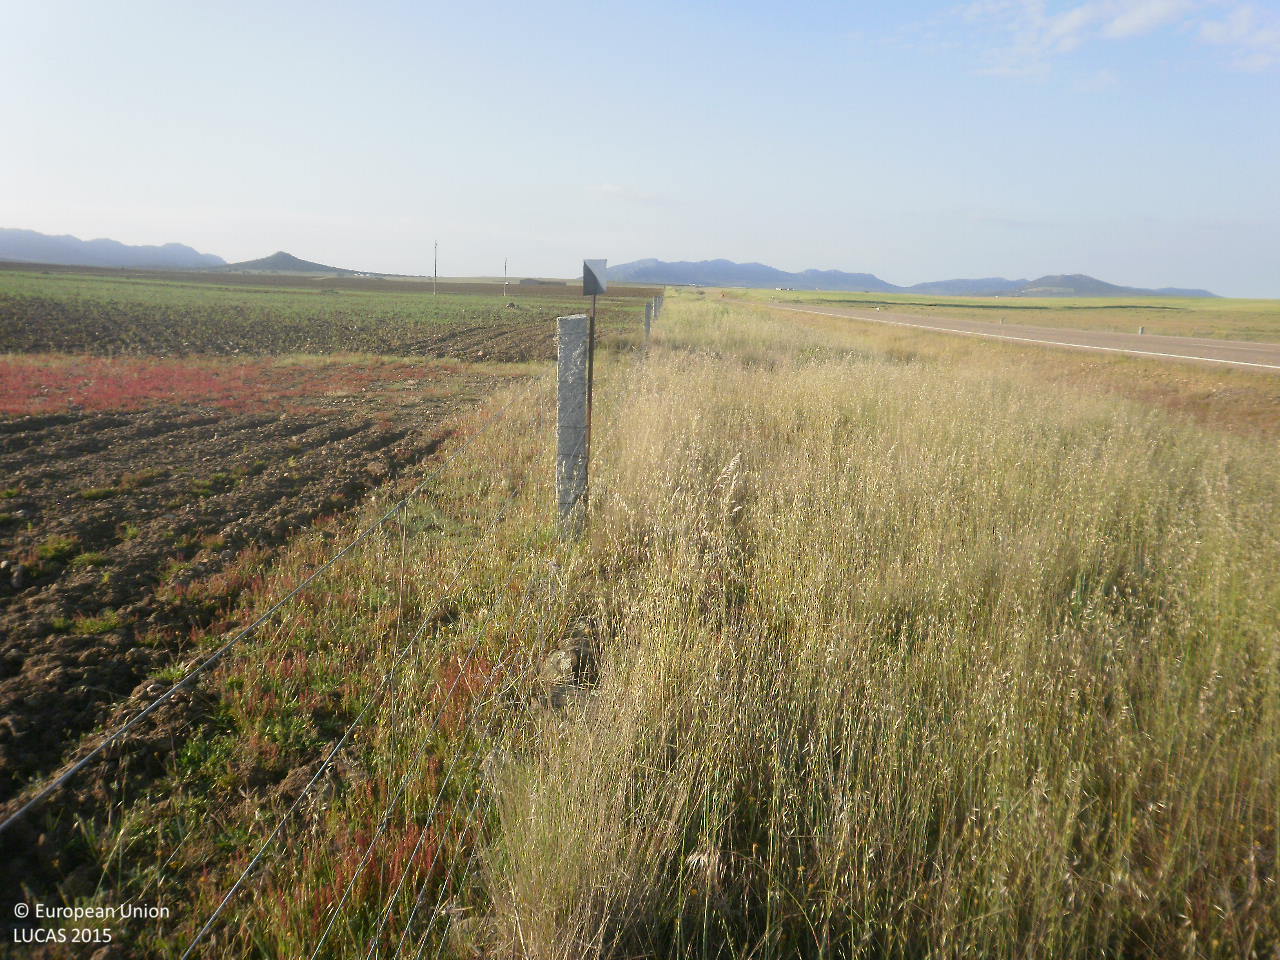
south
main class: Cropland
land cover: Dry pulses
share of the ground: > 75 %
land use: Agriculture (excluding fallow land and kitchen gardens)
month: April
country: ES
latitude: 38.7996
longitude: -5.1998
